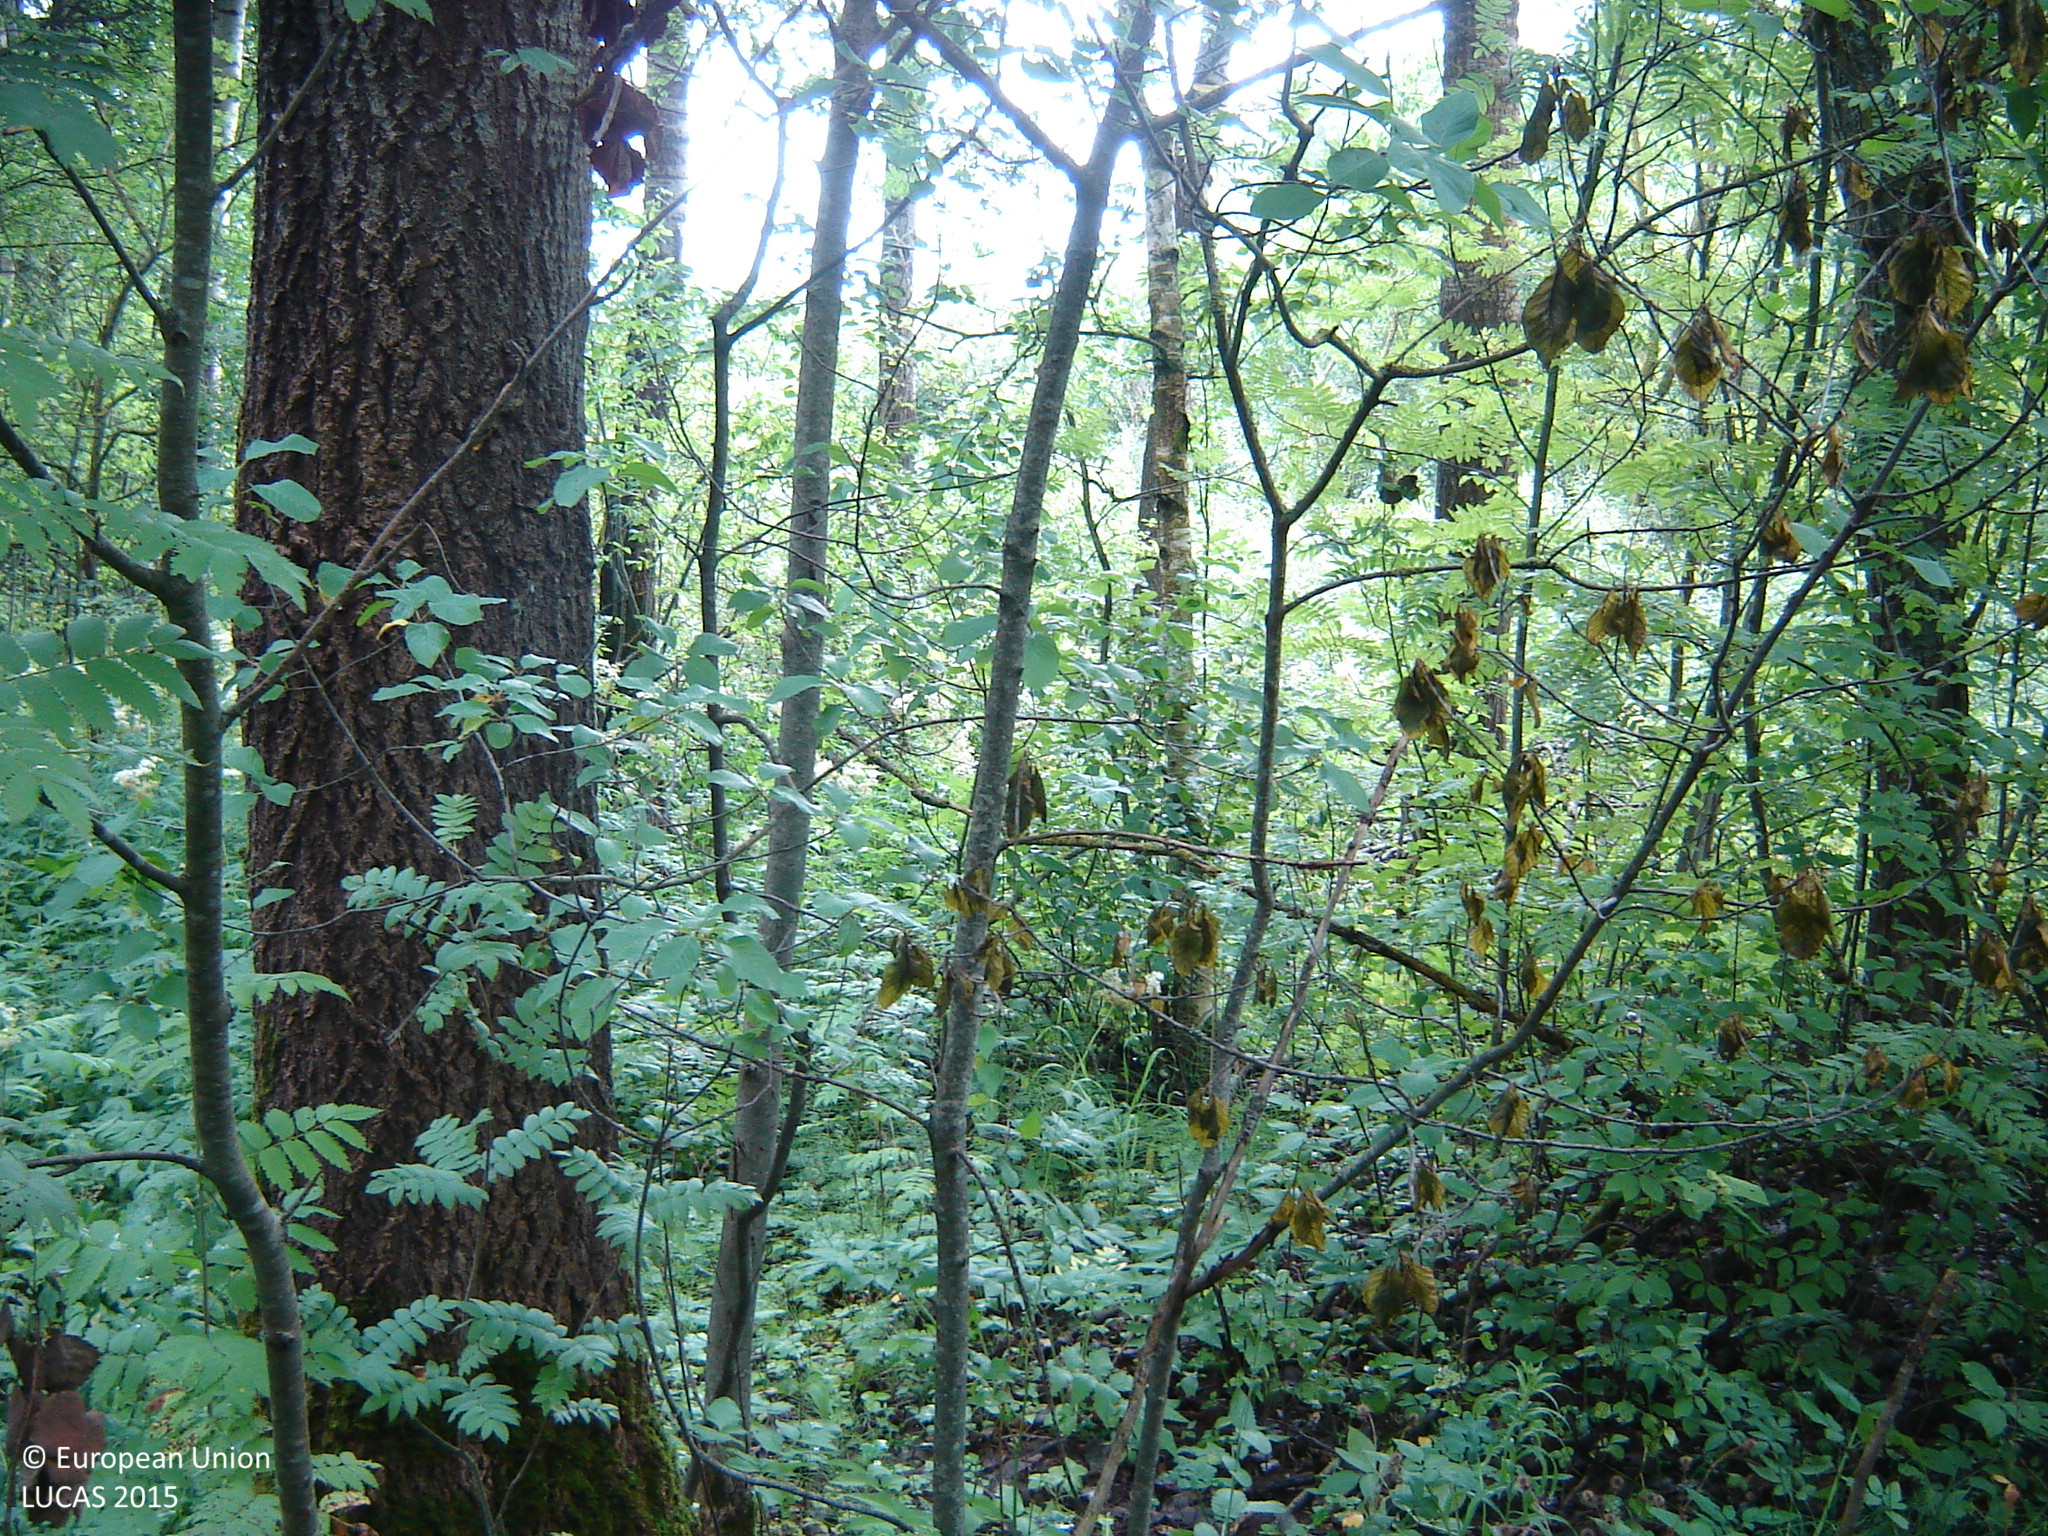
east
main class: Woodland
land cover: Broadleaved woodland
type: non-riverine alder, birch or aspen forest
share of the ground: > 75 %
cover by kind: broadleaved forest trees 90 %, herbaceous plants 10 %
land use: Forestry
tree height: > 5 m
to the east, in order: Broadleaved woodland; Inland marshes; Broadleaved woodland; Electric lines; Broadleaved woodland; Shruby margins; Grassland without tree/shrub cover; Broadleaved woodland; Grassland without tree/shrub cover; Broadleaved woodland; Ditches and canals; Broadleaved woodland; Grassland without tree/shrub cover
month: July
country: LT
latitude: 55.3330
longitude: 25.1712
